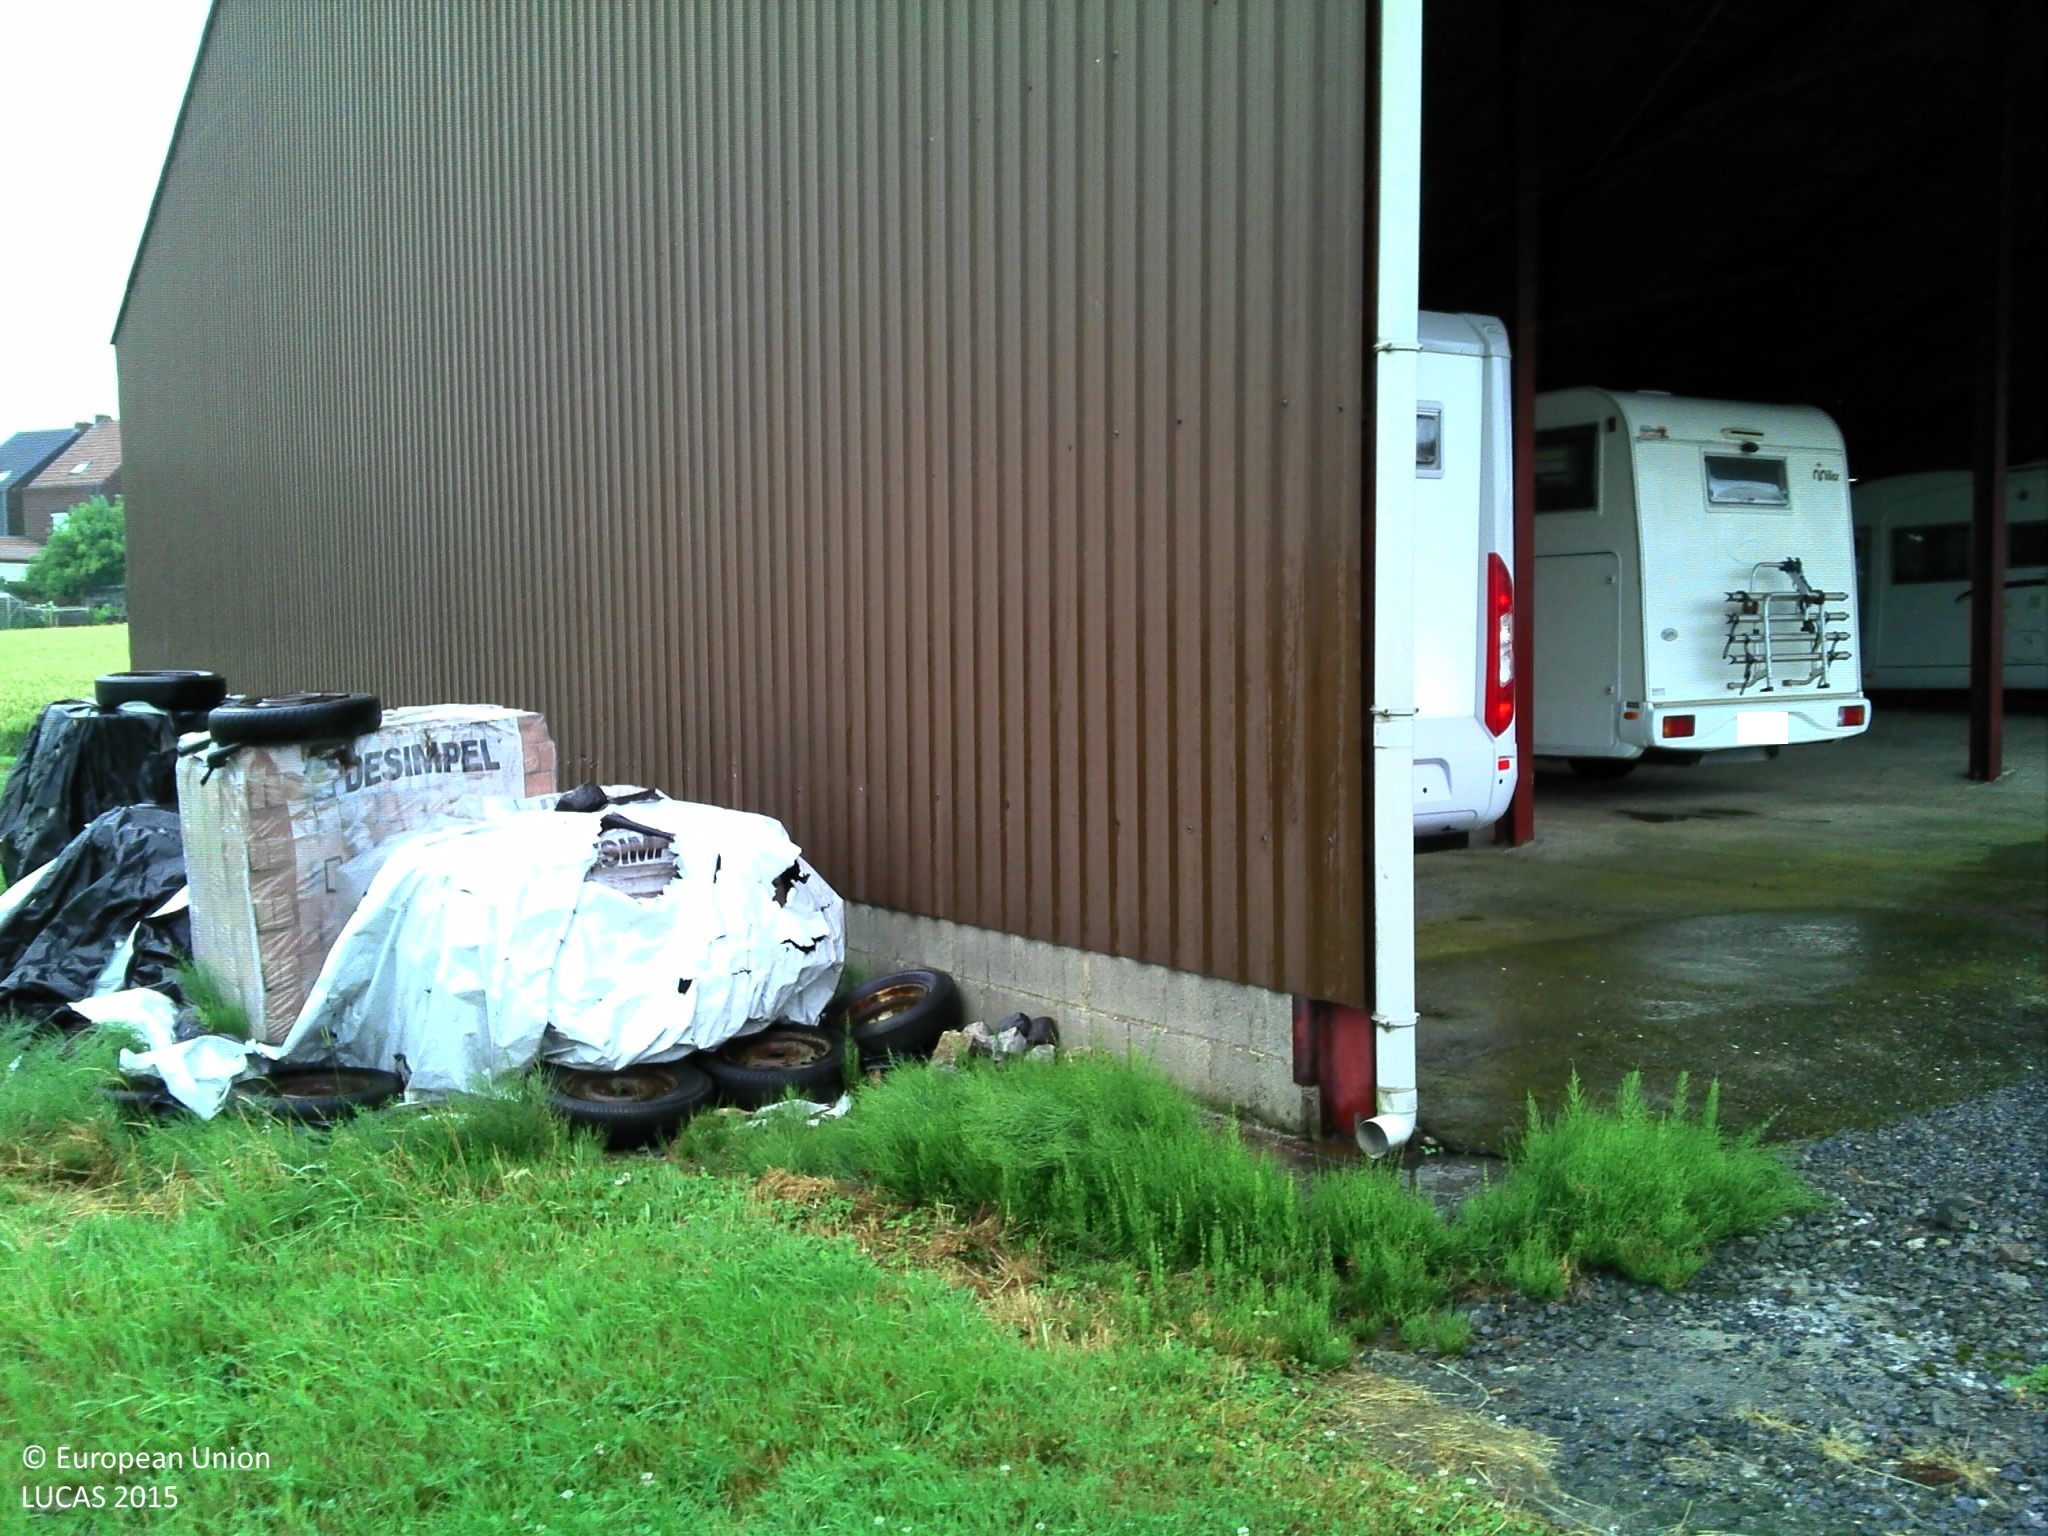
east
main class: Cropland
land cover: Common wheat
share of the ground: > 75 %
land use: Agriculture (excluding fallow land and kitchen gardens)
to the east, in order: Common wheat; Artificial constructions in urban areas; Grassland without tree/shrub cover
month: July
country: BE
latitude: 50.4817
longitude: 4.0896
